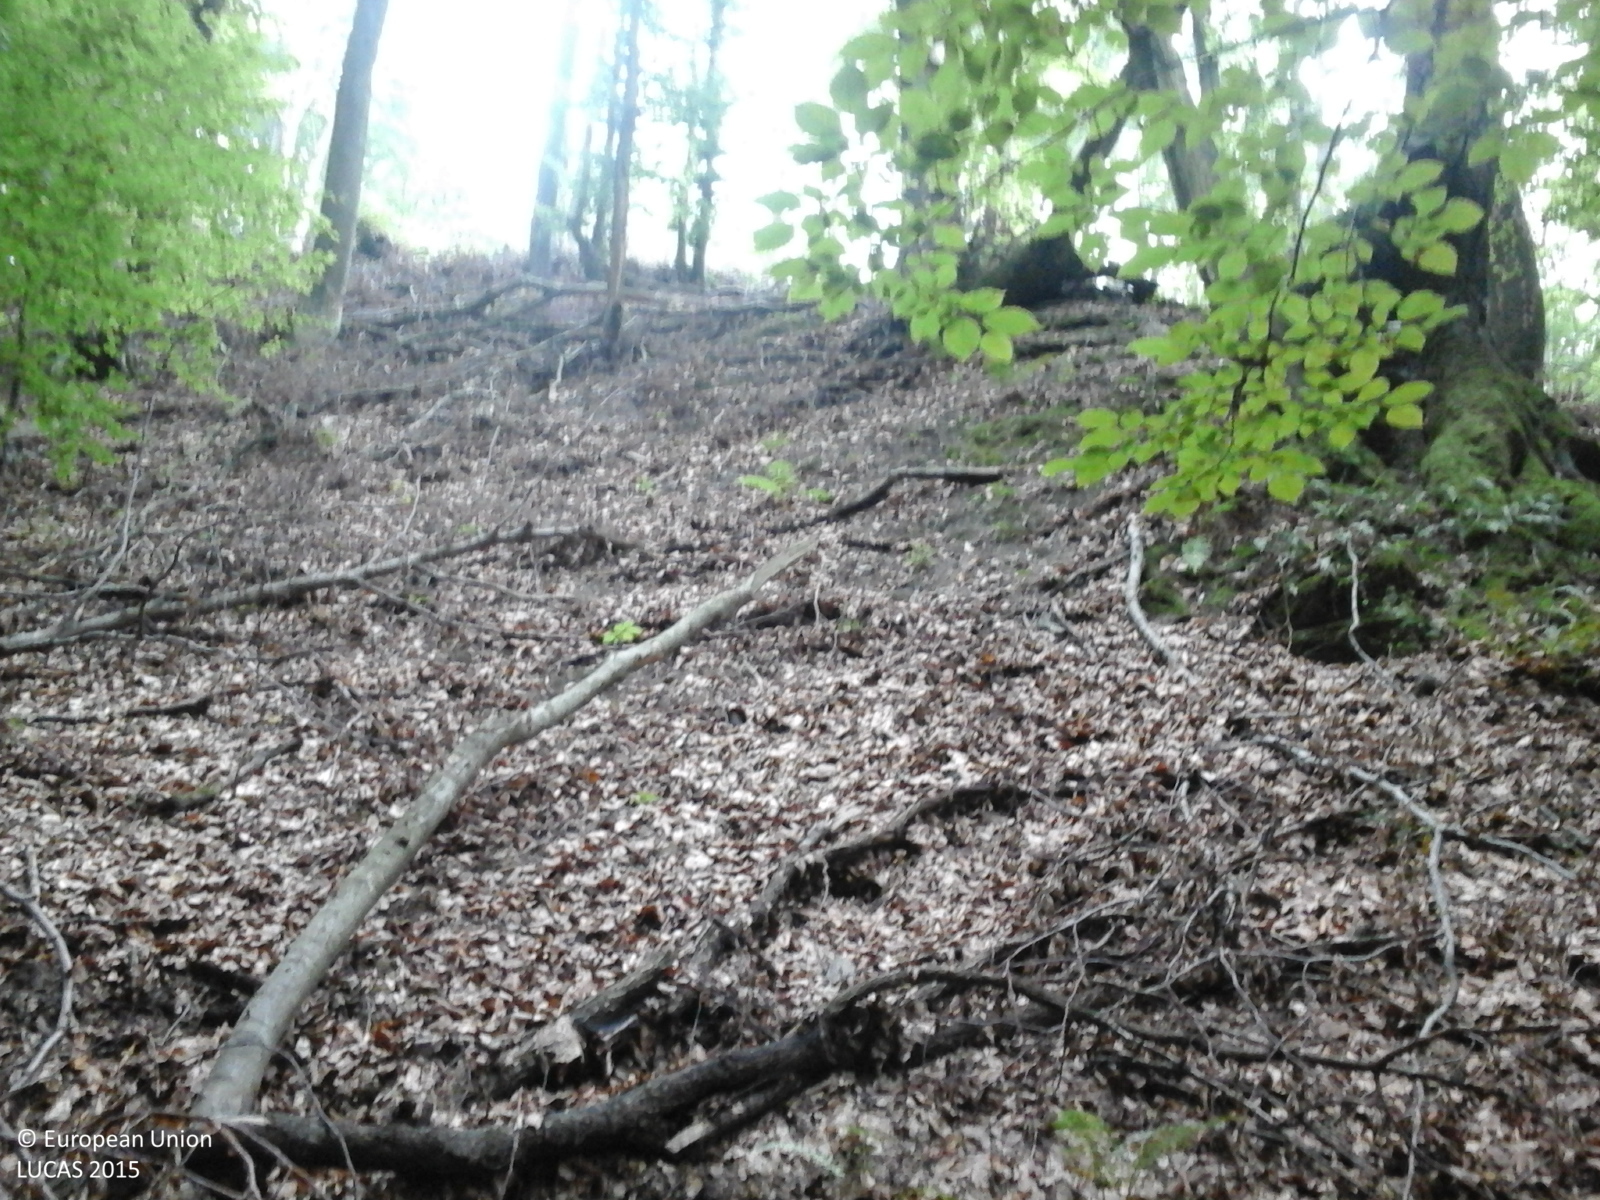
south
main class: Woodland
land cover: Broadleaved woodland
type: mesophytic deciduous forest
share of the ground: > 75 %
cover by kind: broadleaved forest trees 100 %
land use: Forestry
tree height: > 5 m
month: September
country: RO
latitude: 45.9033
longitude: 22.8268
